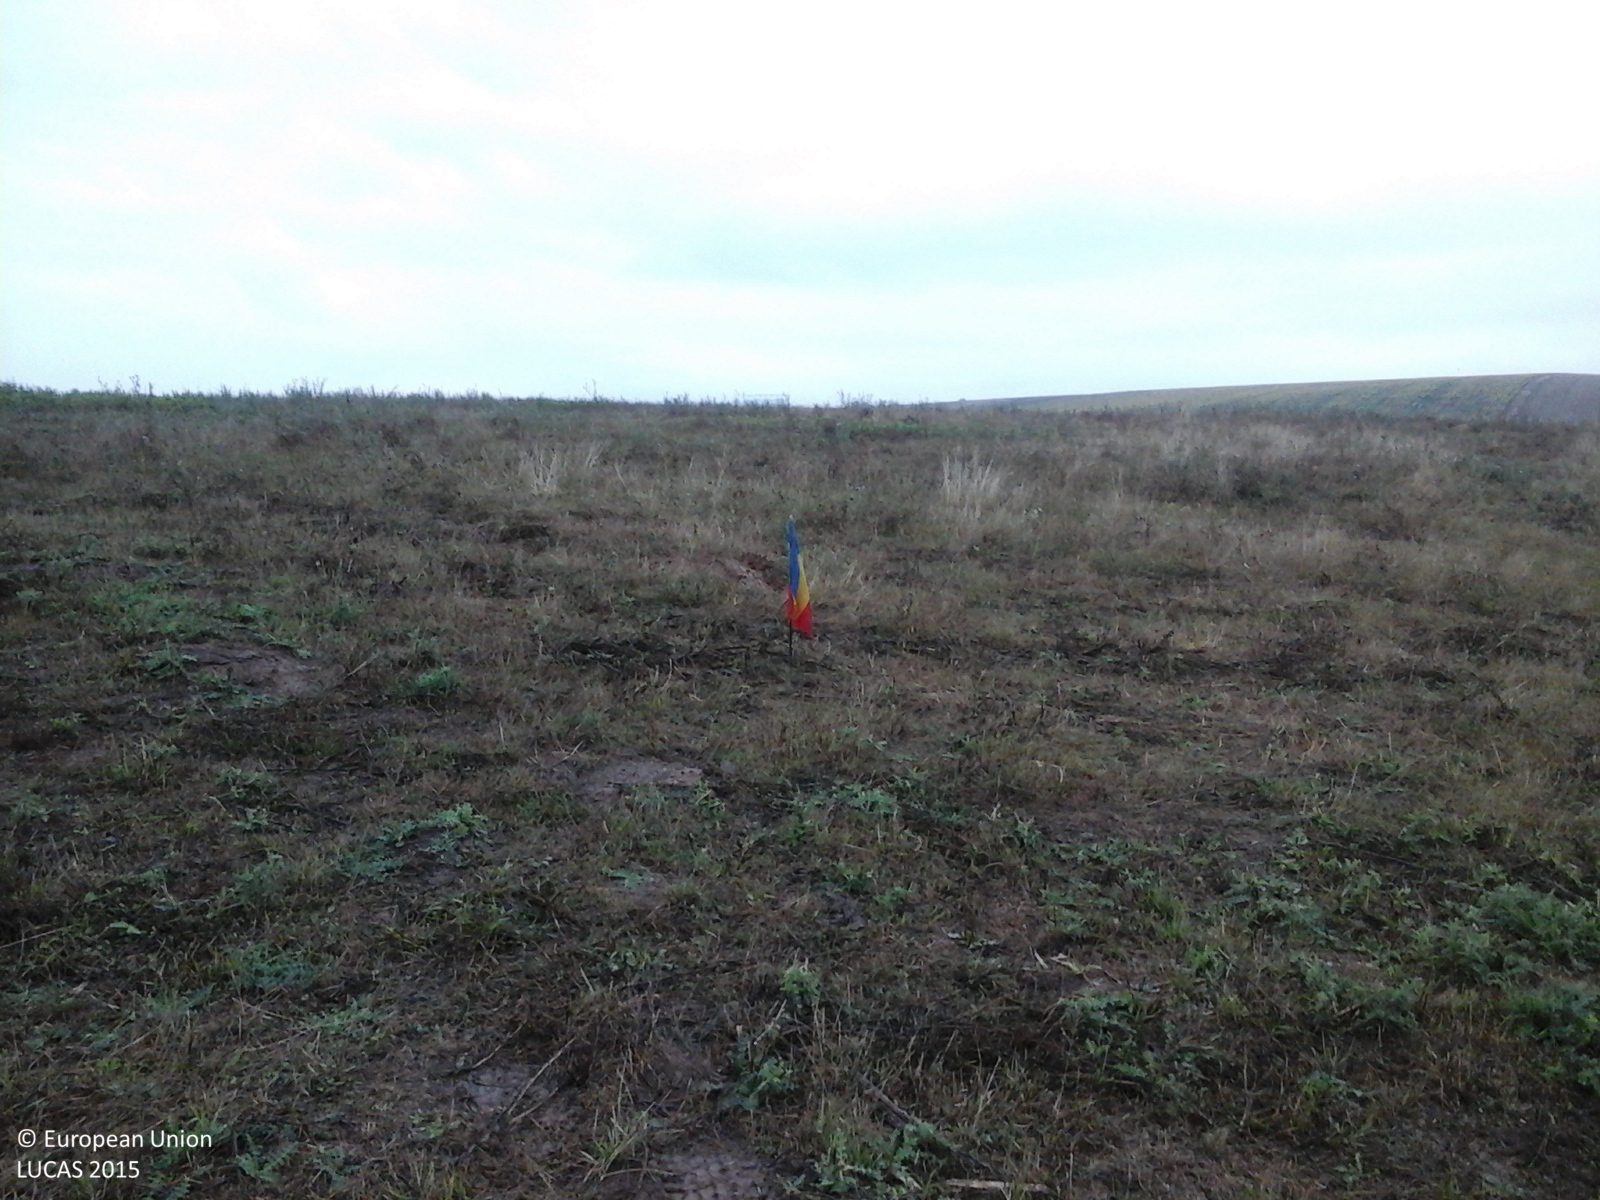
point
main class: Grassland
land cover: Spontaneously vegetated surfaces
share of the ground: > 75 %
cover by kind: herbaceous plants 100 %
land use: Fallow land
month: August
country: RO
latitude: 45.4967
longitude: 21.4594
